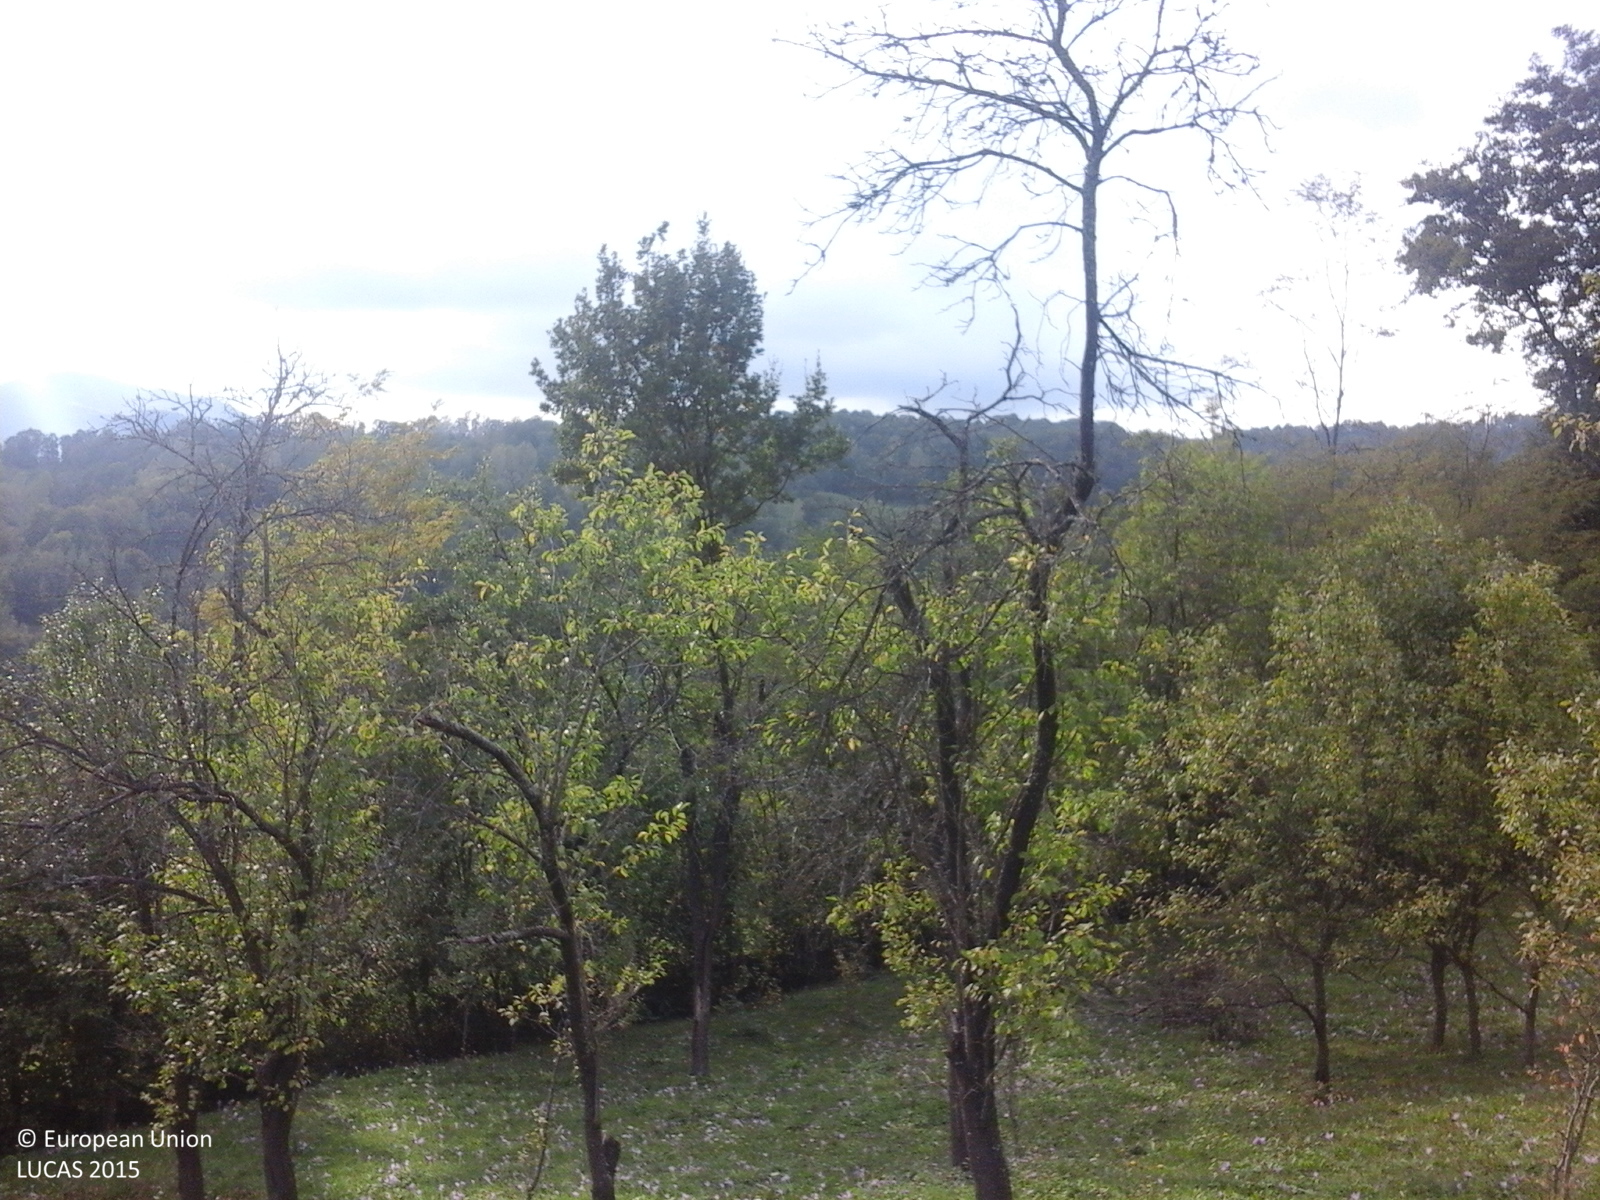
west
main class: Cropland
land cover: Other fruit trees and berries
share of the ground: > 75 %
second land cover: Grassland without tree/shrub cover
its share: > 75 %
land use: Agriculture (excluding fallow land and kitchen gardens)
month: October
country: RO
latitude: 46.1280
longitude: 23.2229
